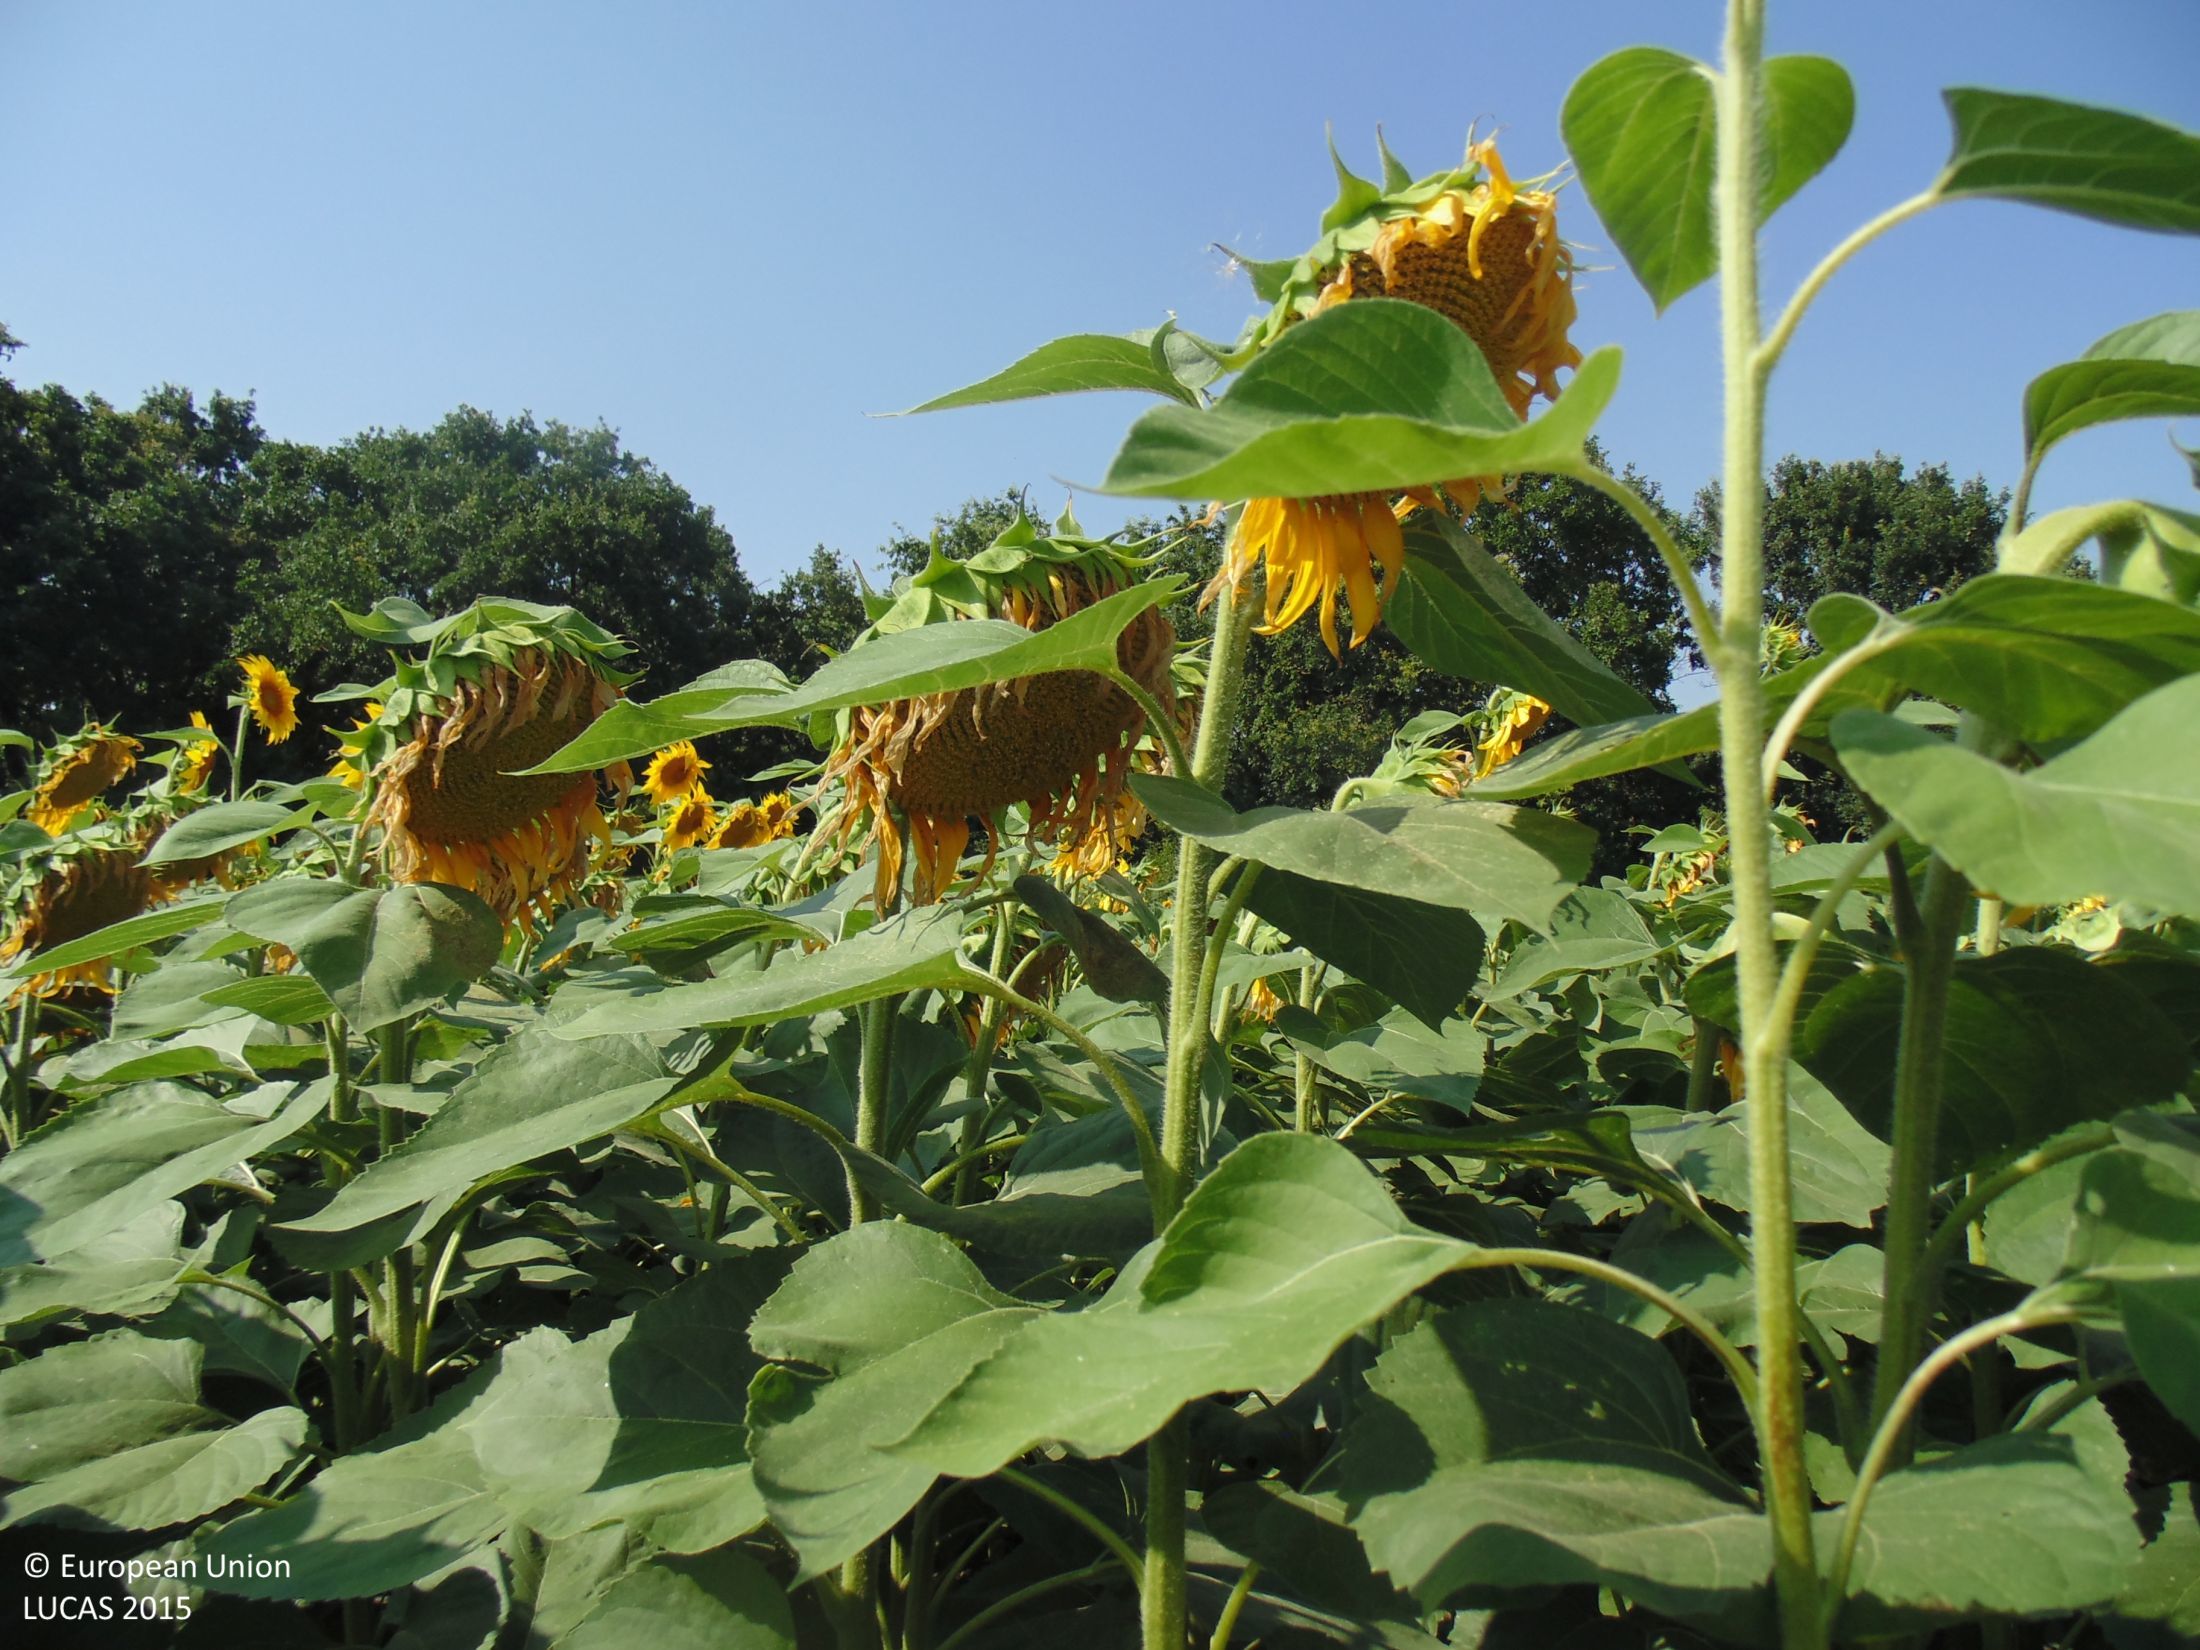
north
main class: Cropland
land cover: Sunflower
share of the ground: > 75 %
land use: Agriculture (excluding fallow land and kitchen gardens)
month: July
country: BG
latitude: 43.4999
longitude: 27.9915
